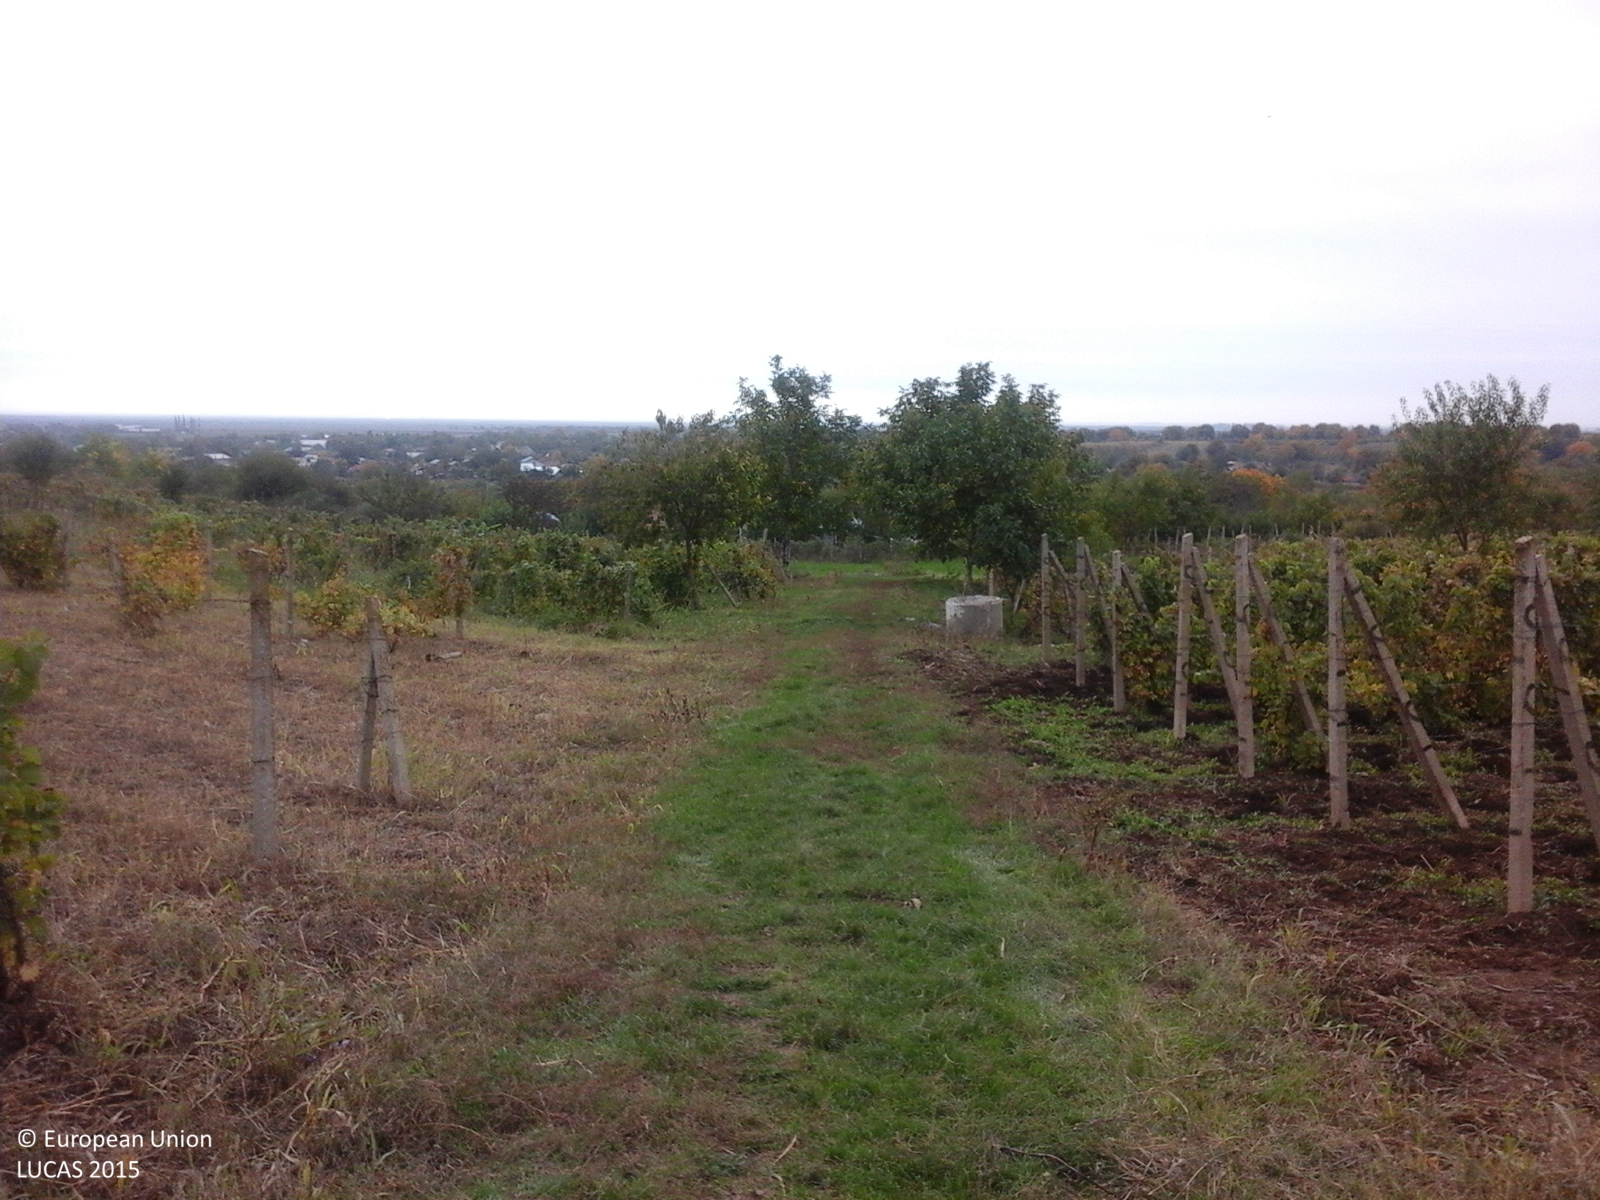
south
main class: Cropland
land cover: Vineyards
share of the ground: 25 - 50 %
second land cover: Grassland without tree/shrub cover
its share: > 75 %
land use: Agriculture (excluding fallow land and kitchen gardens)
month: October
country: RO
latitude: 45.0407
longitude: 26.3802
